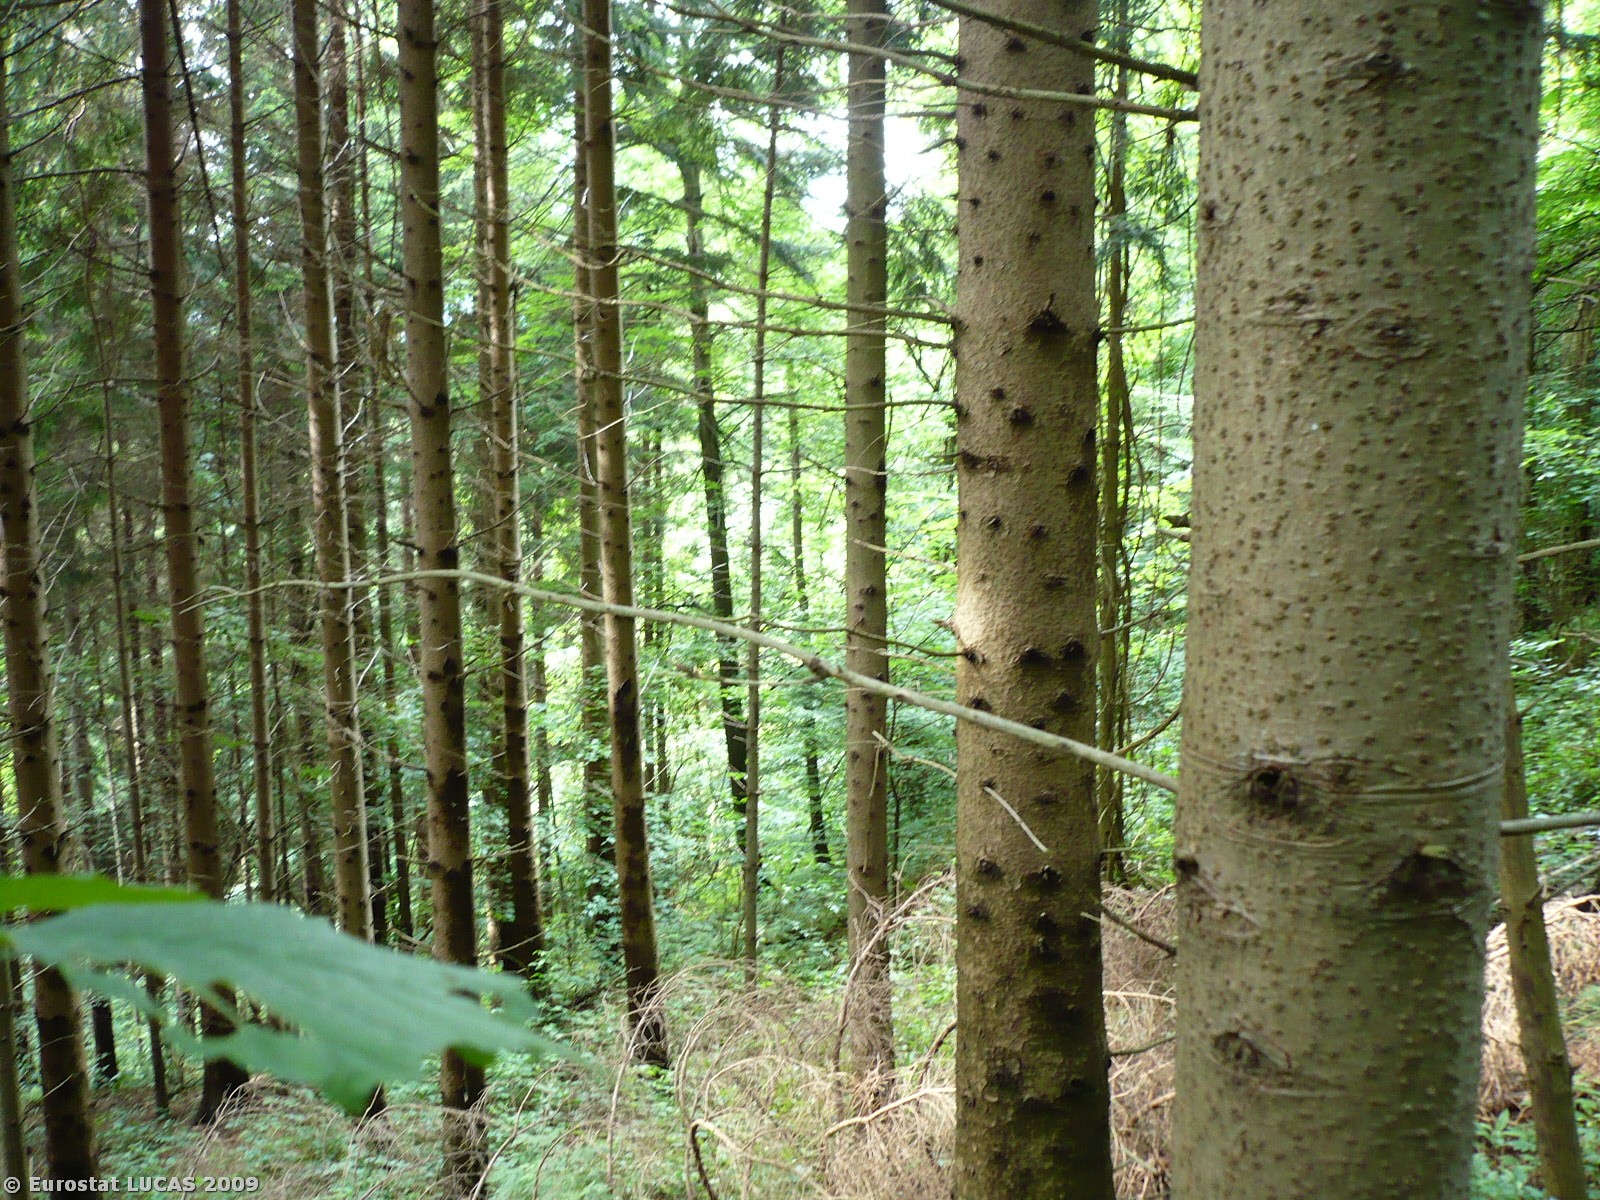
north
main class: Woodland
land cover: Mixed woodland
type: beech forest
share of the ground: > 75 %
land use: Forestry
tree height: > 5 m
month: June
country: SI
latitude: 46.0724
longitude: 13.6553
